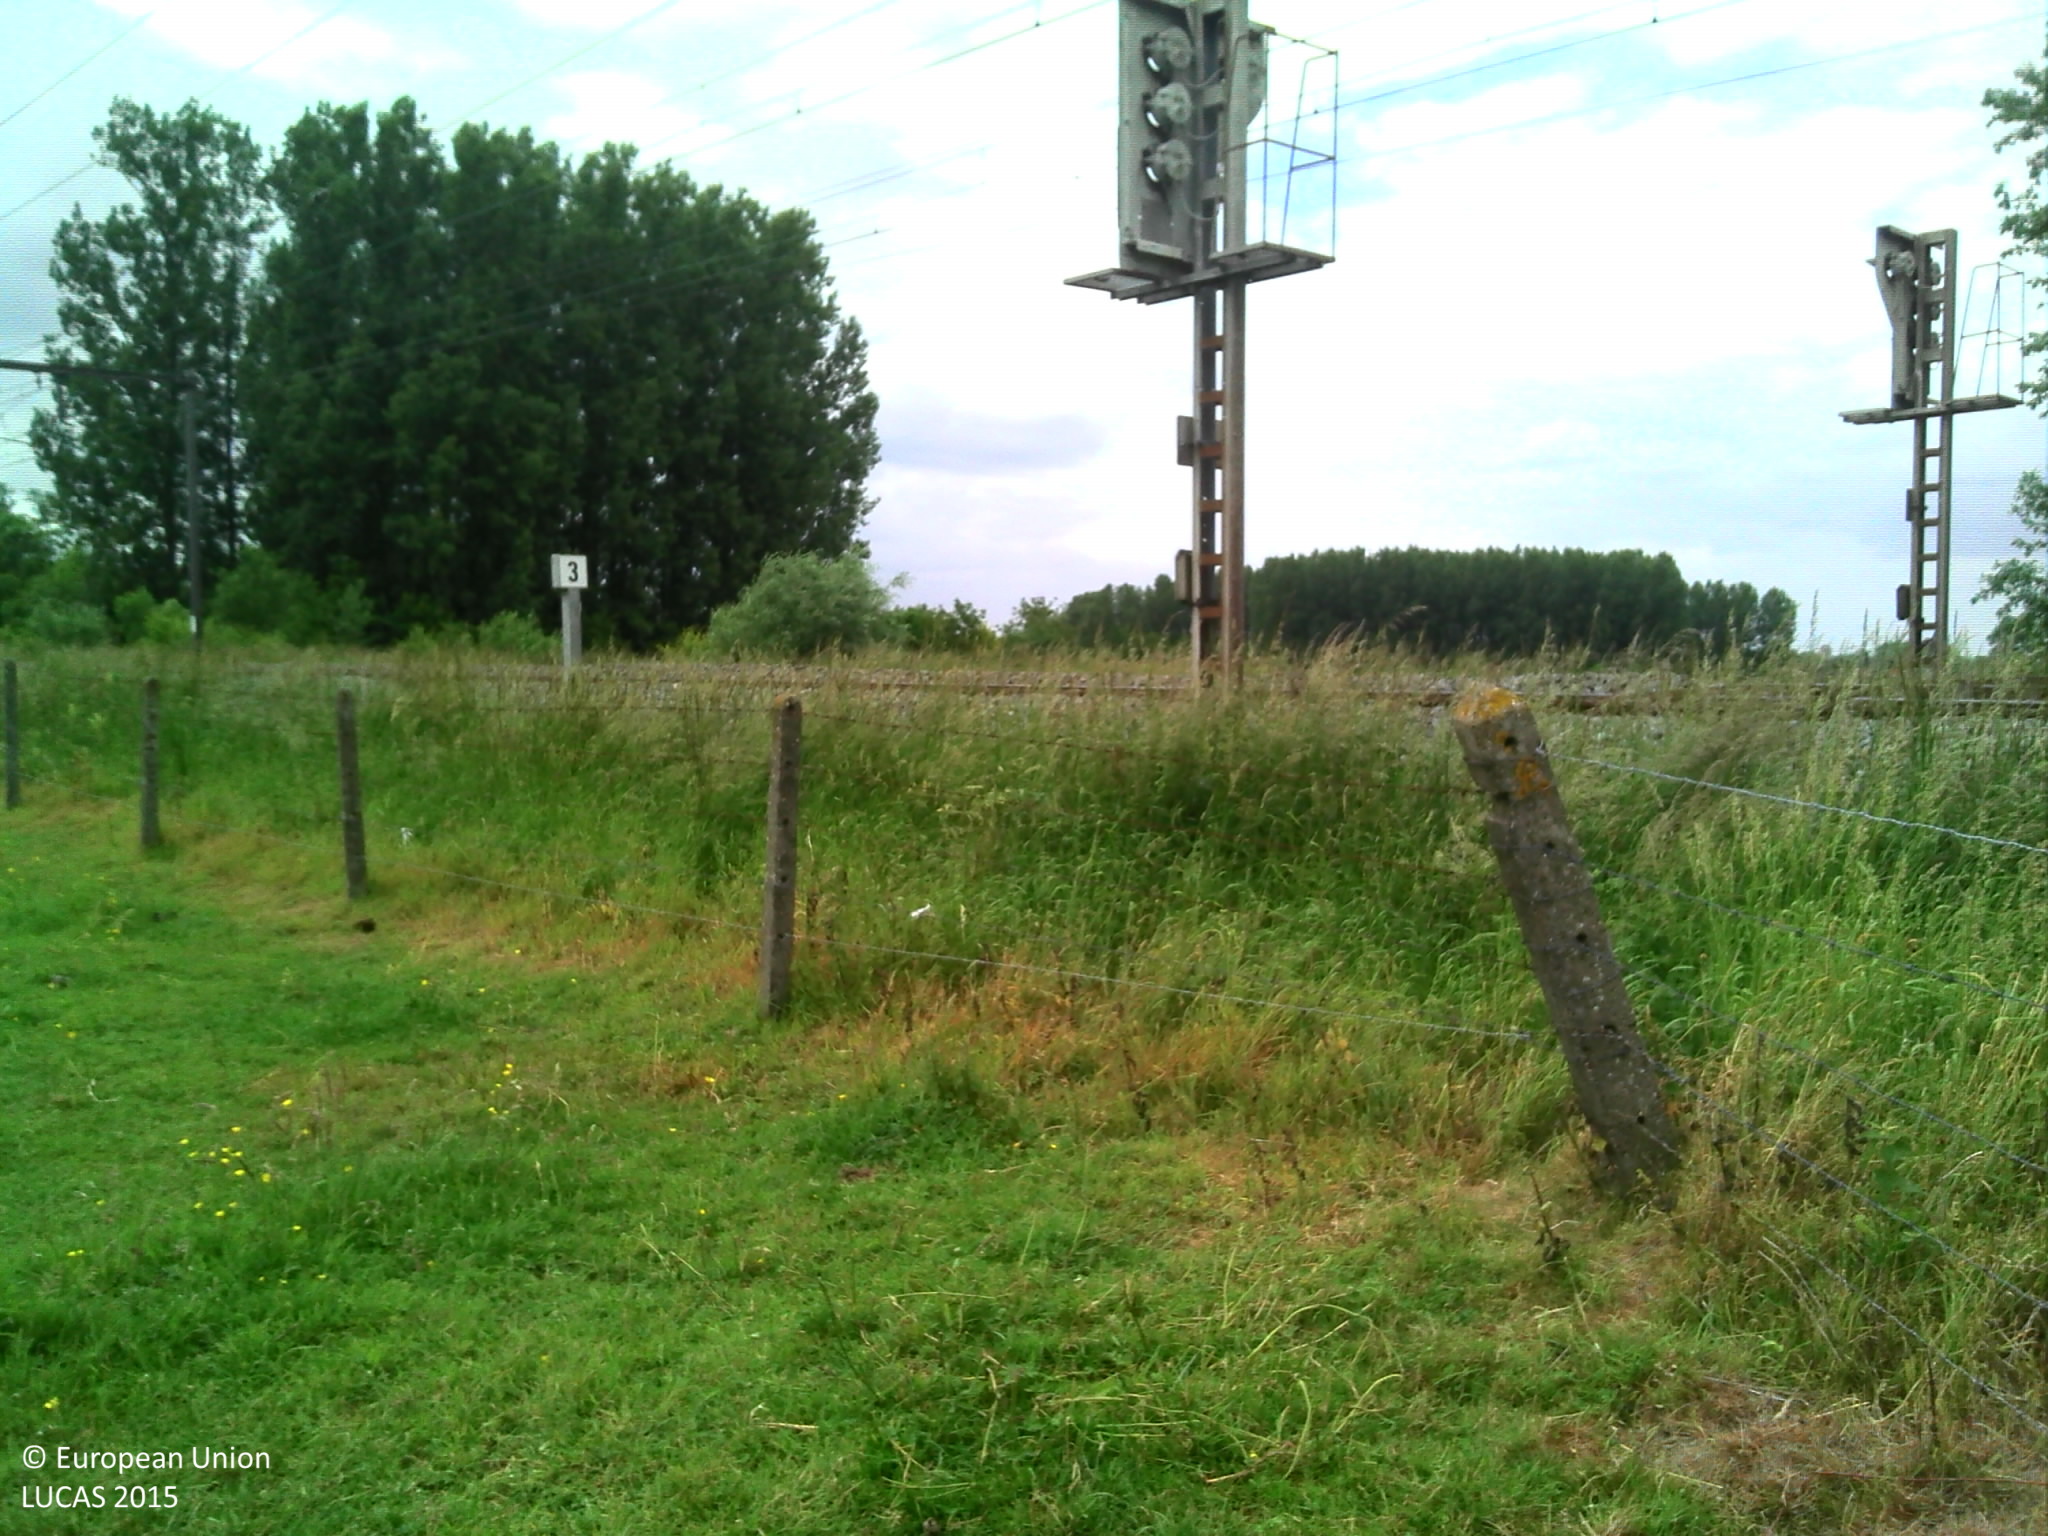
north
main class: Grassland
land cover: Grassland without tree/shrub cover
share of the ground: > 75 %
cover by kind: herbaceous plants 100 %
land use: Agriculture (excluding fallow land and kitchen gardens)
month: June
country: BE
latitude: 50.9101
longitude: 4.0066
